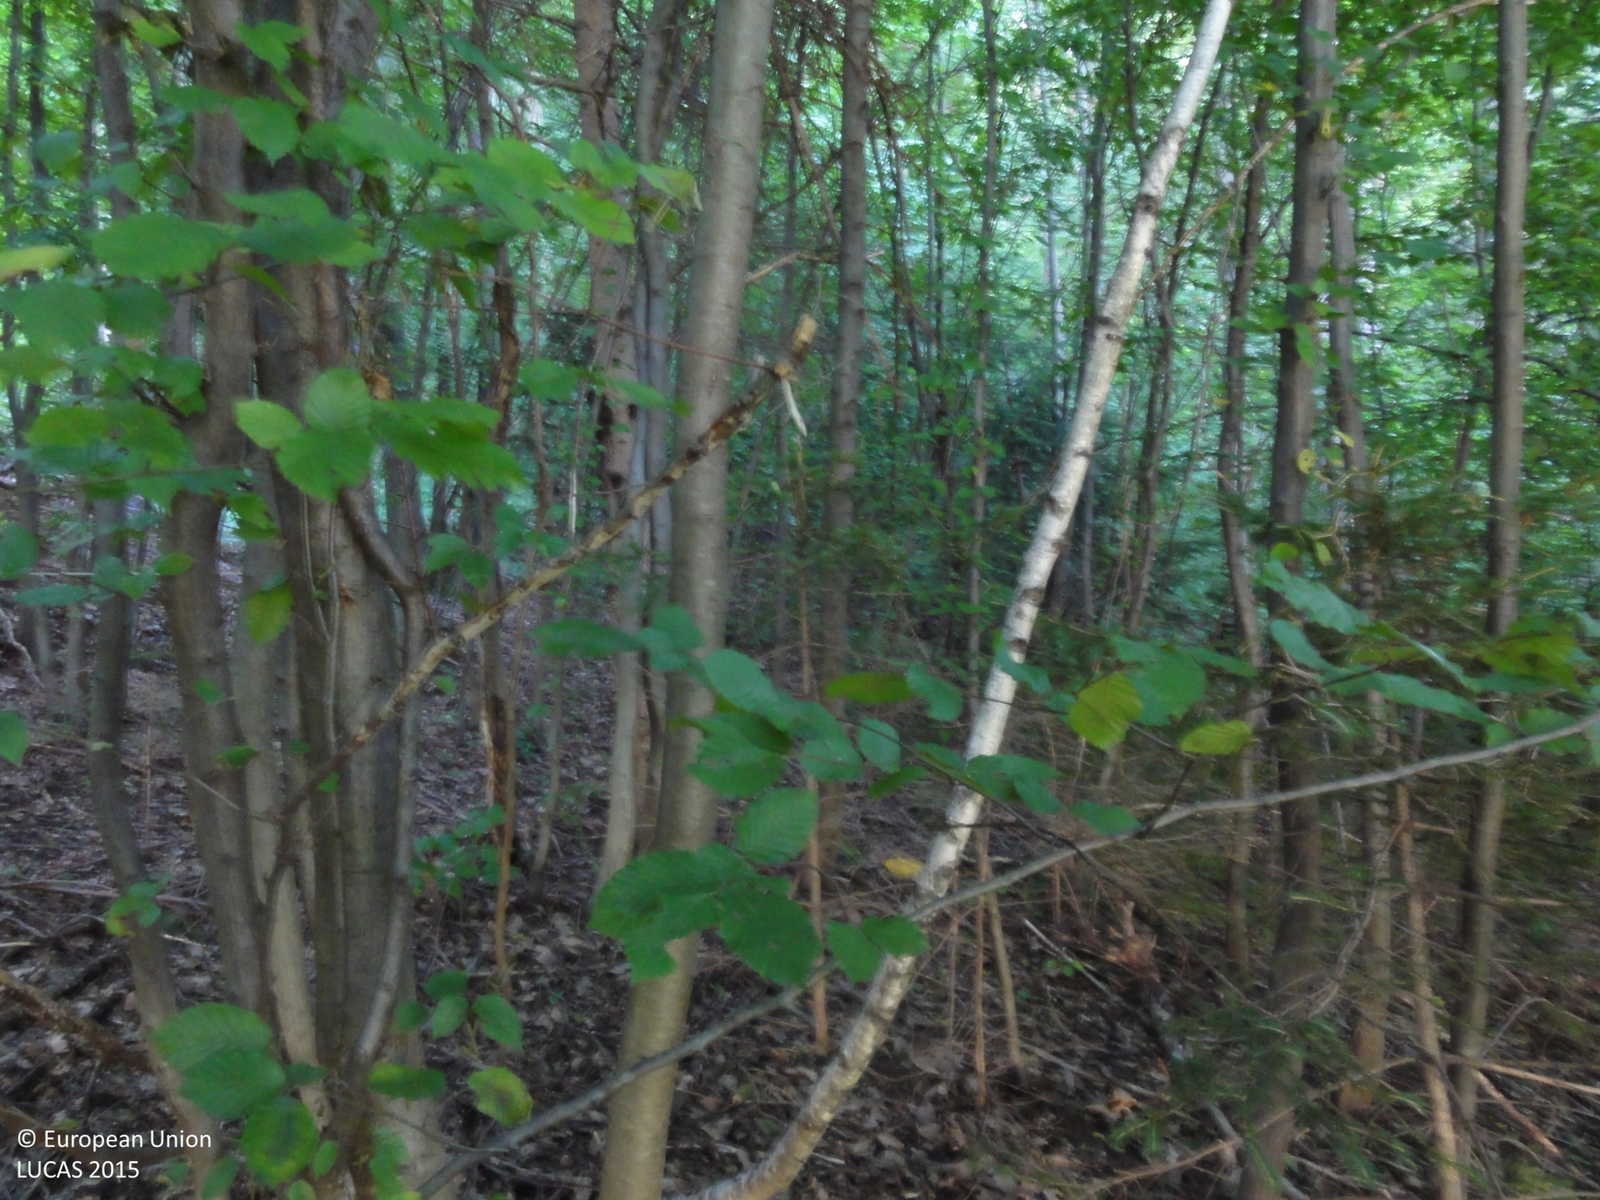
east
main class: Woodland
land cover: Broadleaved woodland
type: mesophytic deciduous forest
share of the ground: > 75 %
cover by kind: broadleaved forest trees 100 %
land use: Forestry
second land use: Amenities, museums, leisure
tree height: > 5 m
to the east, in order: Broadleaved woodland; Tracks; Broadleaved woodland; Spruce dominated mixed woodland; Broadleaved woodland; Tracks; Broadleaved woodland
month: July
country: SI
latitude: 46.3222
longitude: 15.0499
